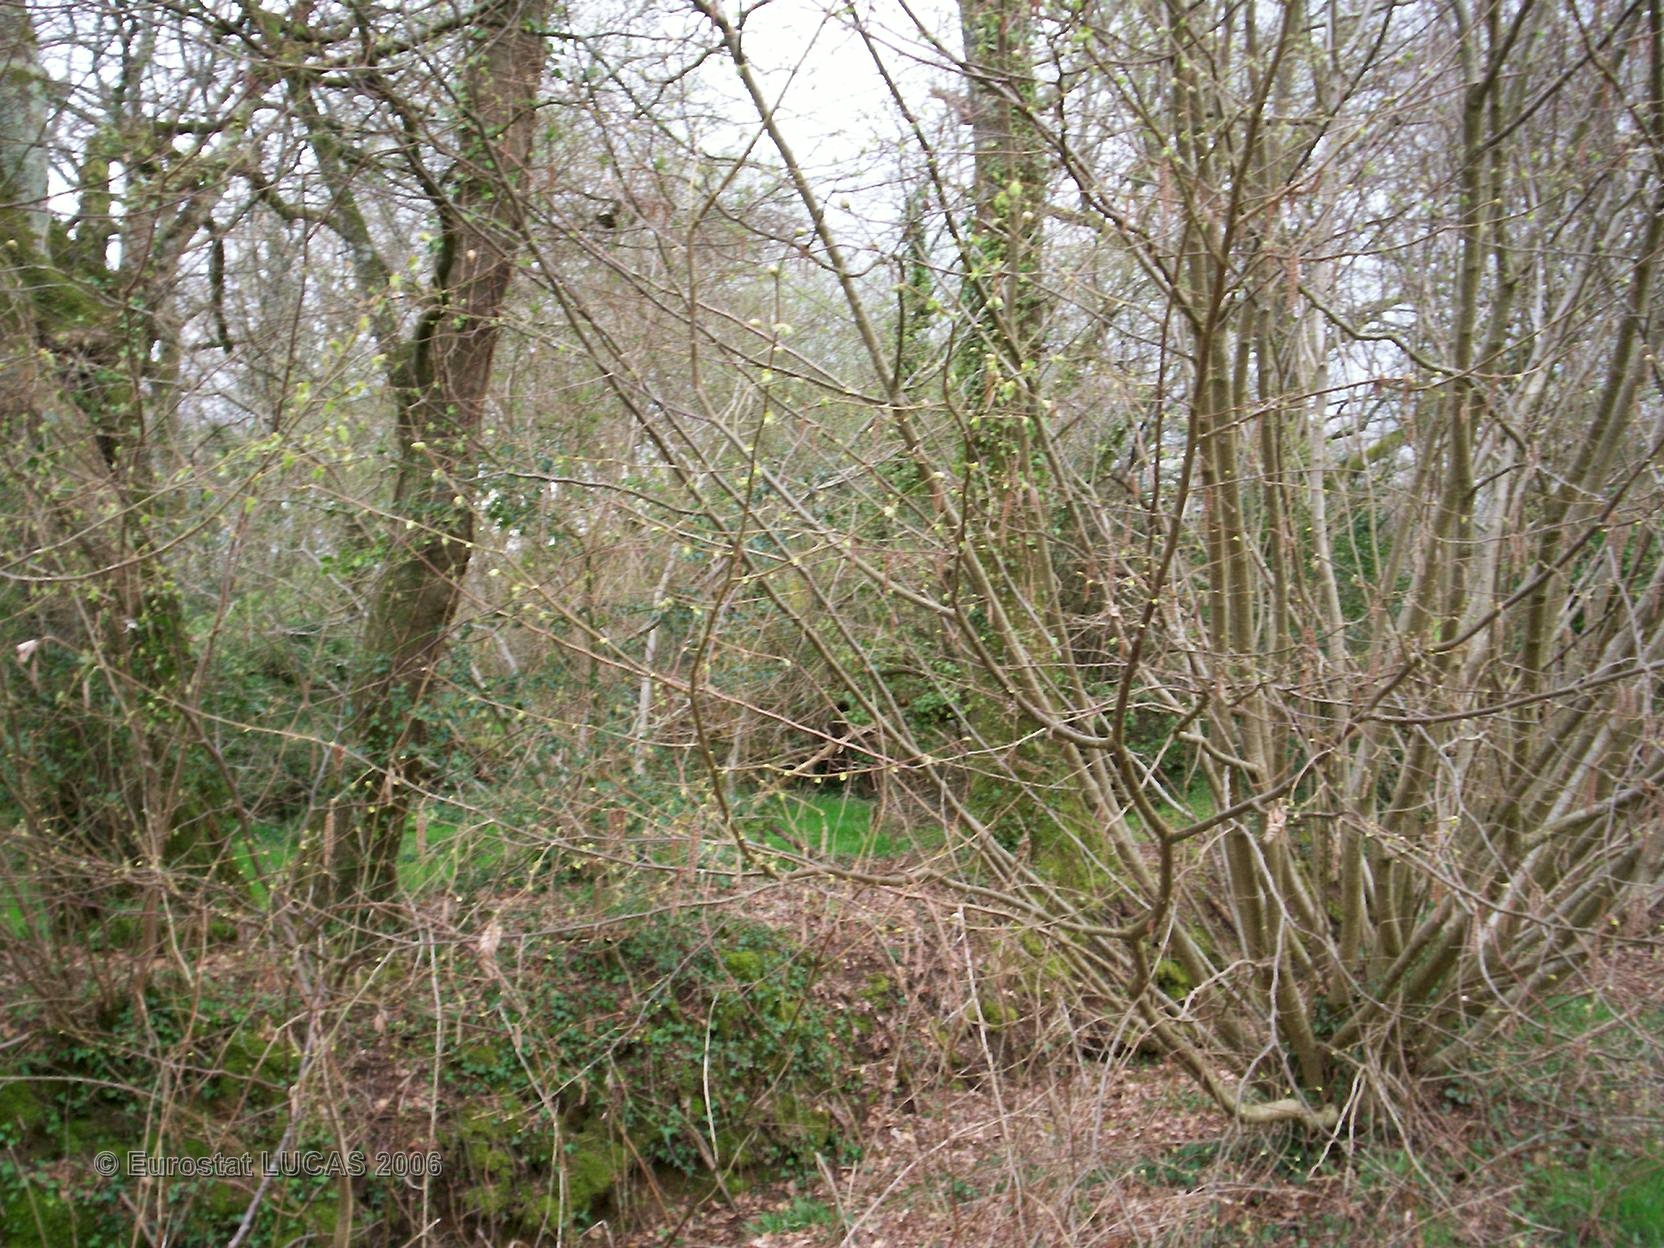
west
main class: Grassland
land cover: Grassland without tree/shrub cover
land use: Agriculture (excluding fallow land and kitchen gardens)
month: April
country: FR
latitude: 47.9321
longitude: -3.5288
